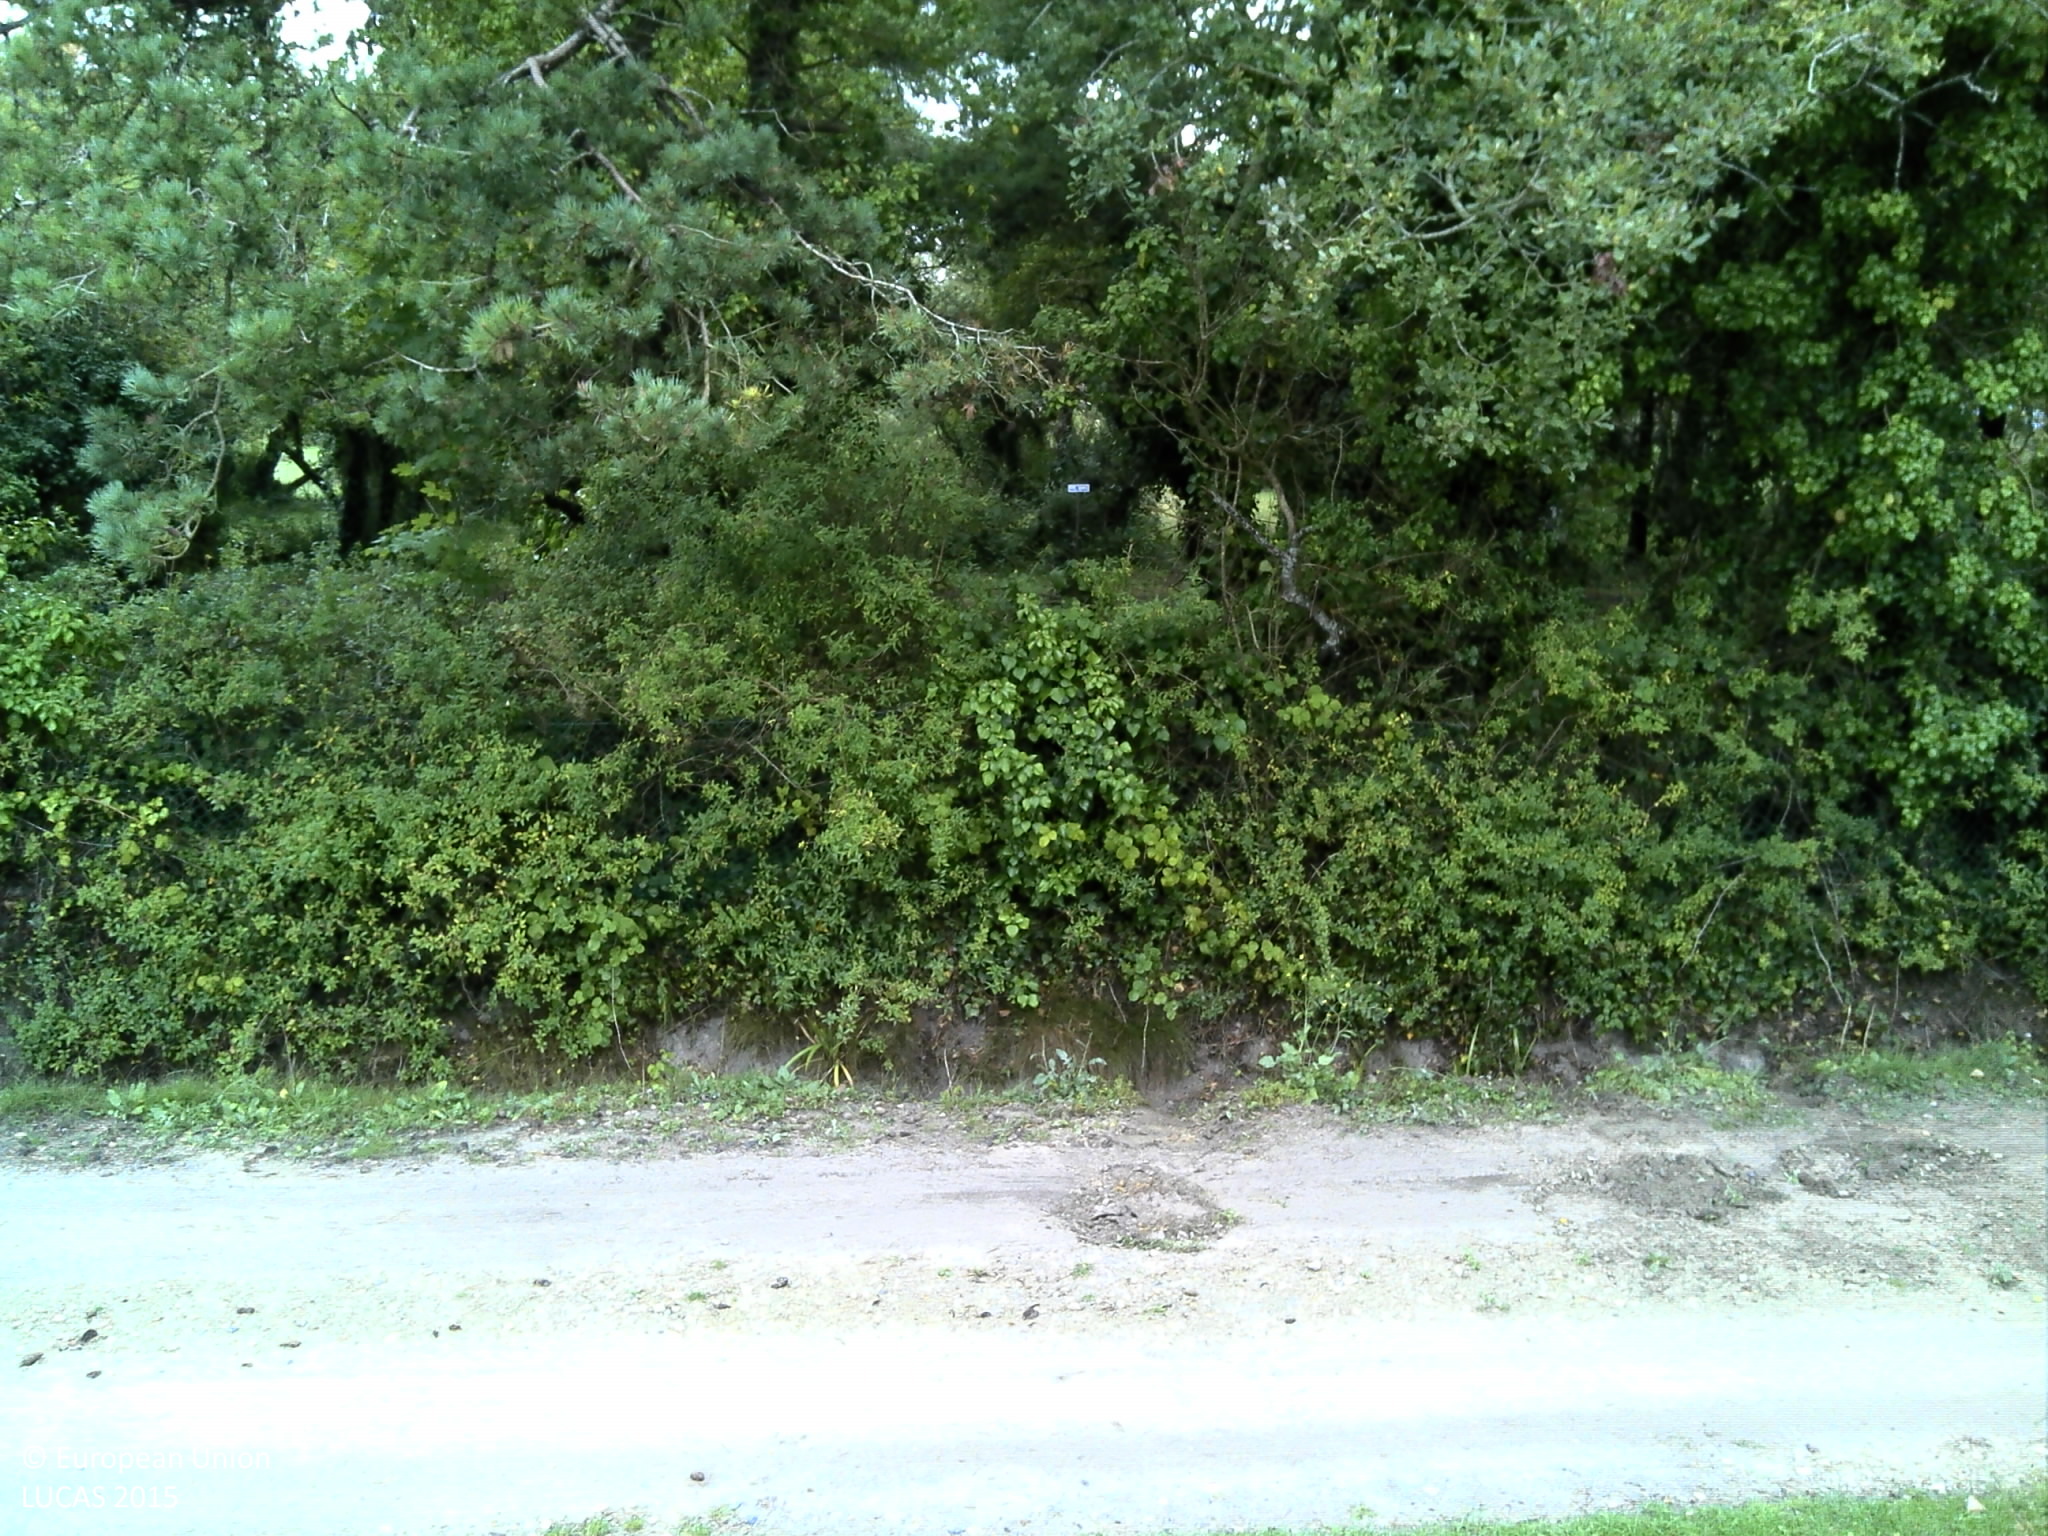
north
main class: Grassland
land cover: Grassland with sparse tree/shrub cover
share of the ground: > 75 %
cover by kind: herbaceous plants 95 %, broadleaved forest trees 5 %
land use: Residential
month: August
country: FR
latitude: 48.6403
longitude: -4.2768
